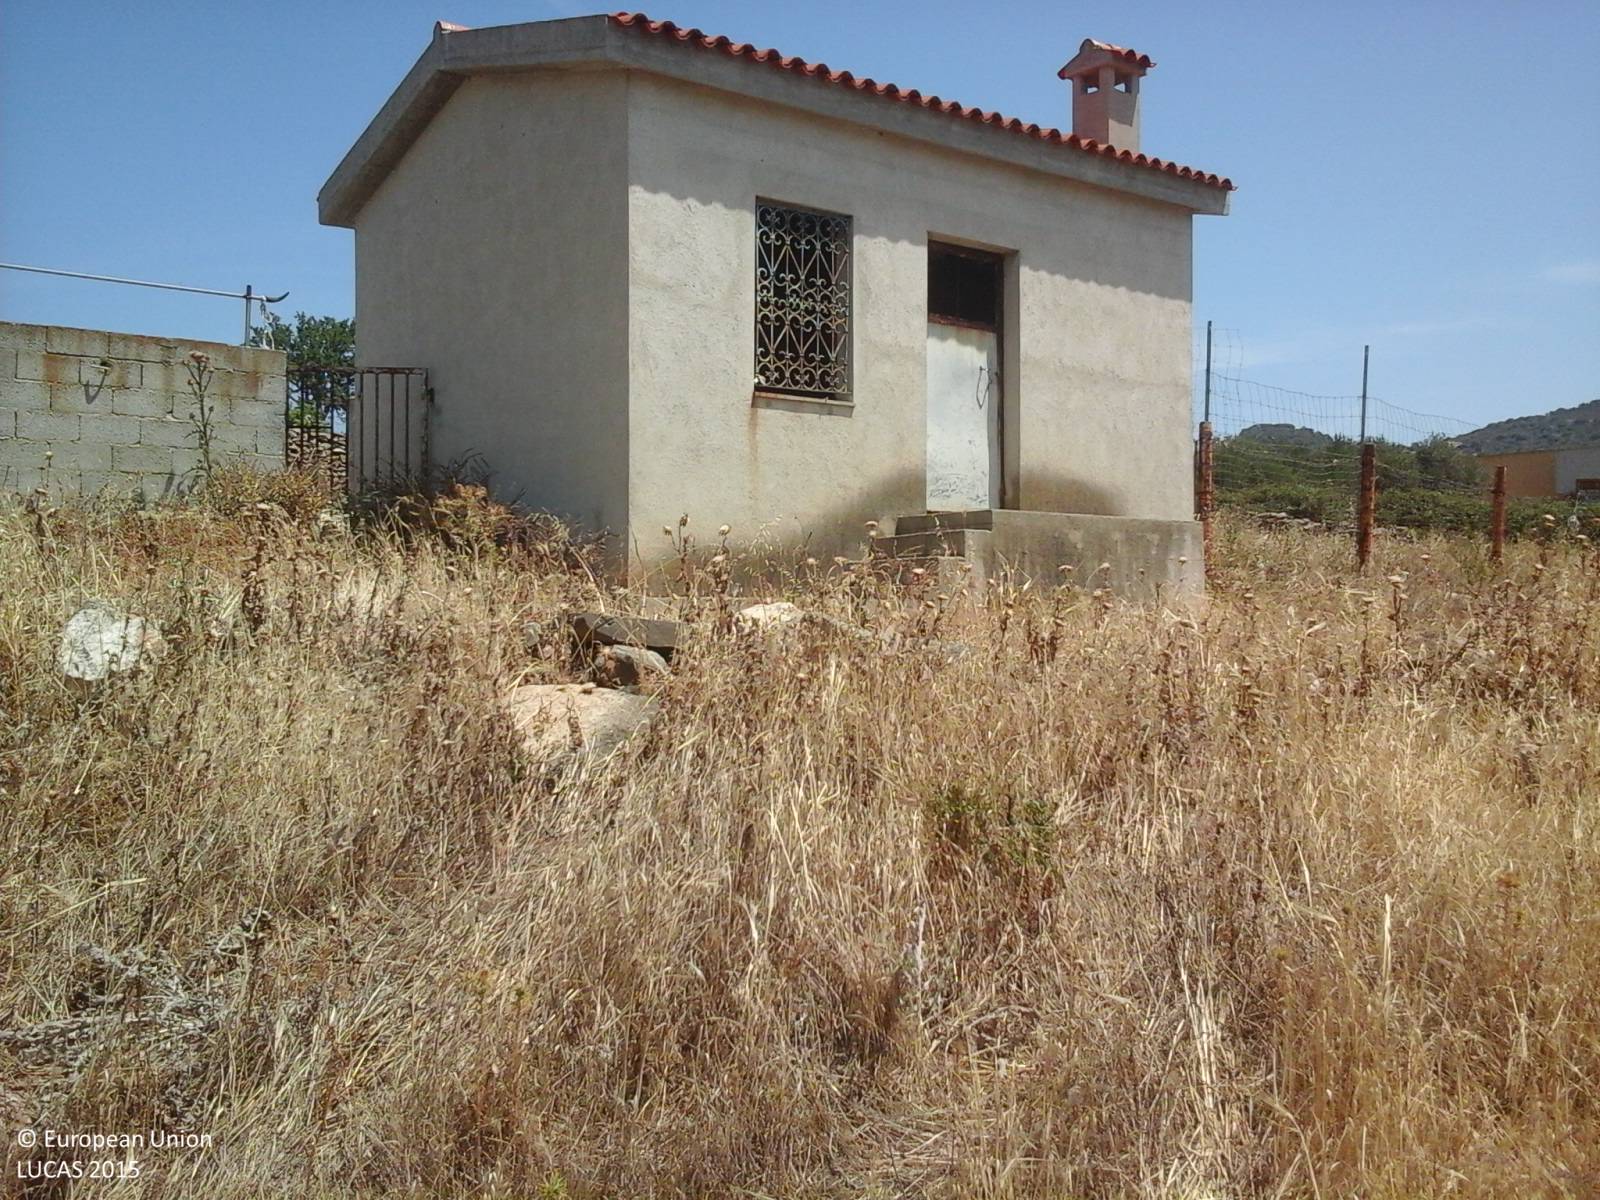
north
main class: Grassland
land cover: Grassland without tree/shrub cover
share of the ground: > 75 %
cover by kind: herbaceous plants 95 %, unconsolidated bare surface 5 %
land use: Agriculture (excluding fallow land and kitchen gardens)
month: June
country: IT
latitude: 40.6648
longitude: 9.6351
